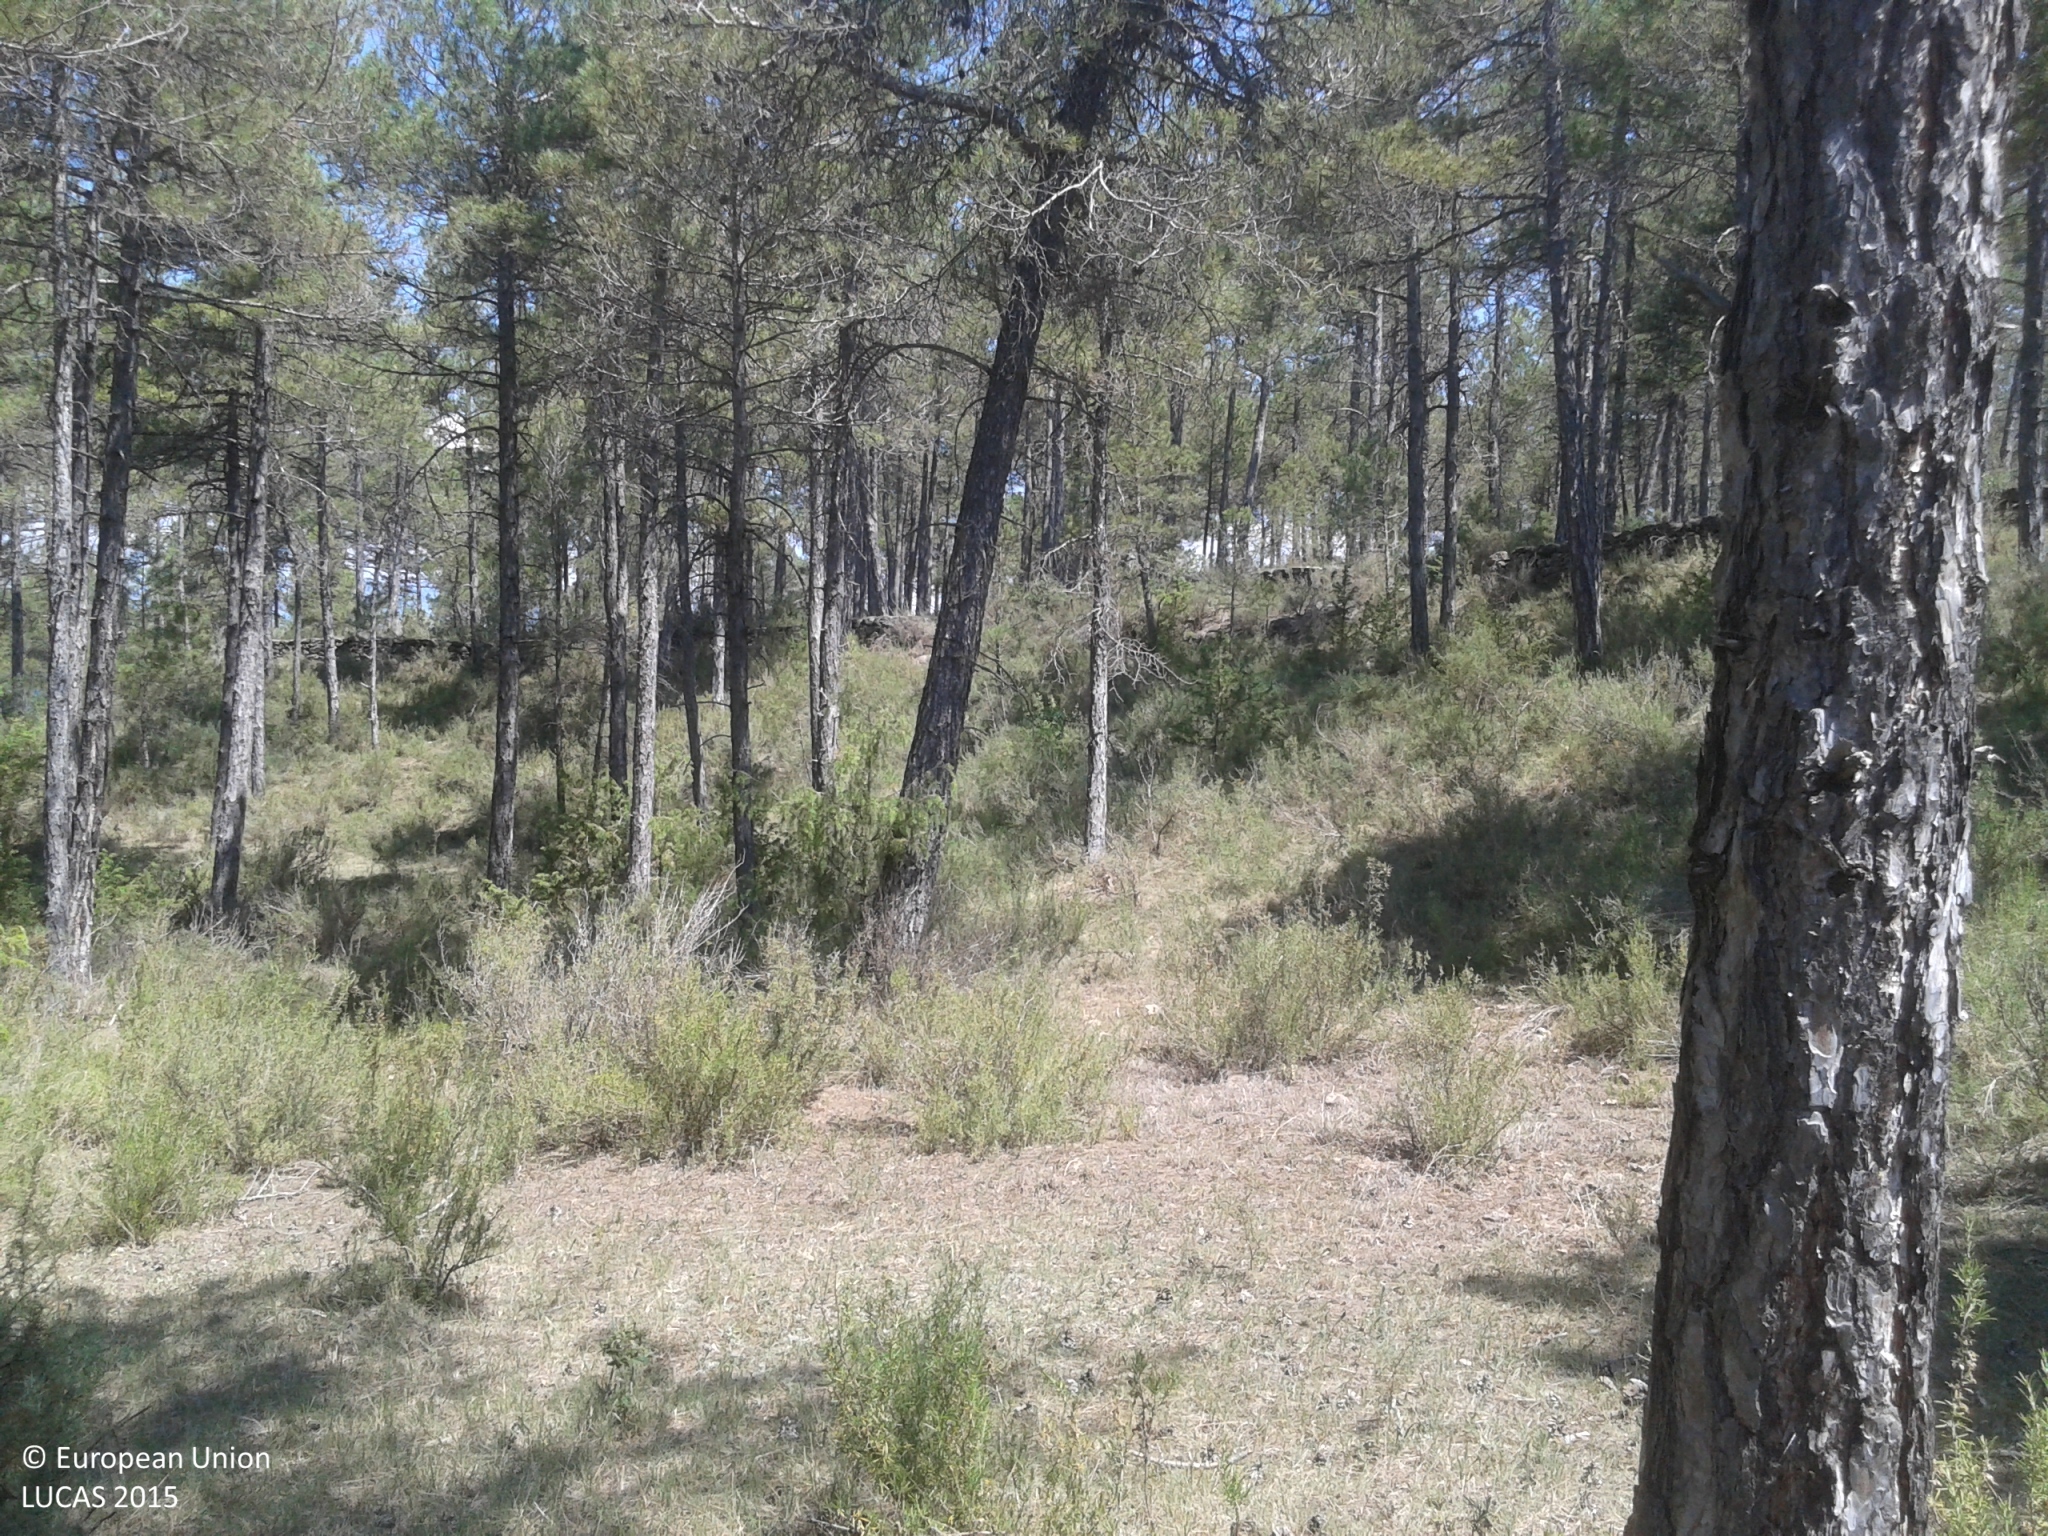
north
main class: Woodland
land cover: Pine dominated coniferous woodland
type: coniferous forest of the mediterranean region
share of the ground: 50 - 75 %
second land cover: Shrubland without tree cover
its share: 10 - 25 %
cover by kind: coniferous forest trees 55 %, herbaceous plants 25 %, shrubs 20 %
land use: Forestry
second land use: Agriculture (excluding fallow land and kitchen gardens)
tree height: > 5 m
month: June
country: ES
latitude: 41.9780
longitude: 1.6011
